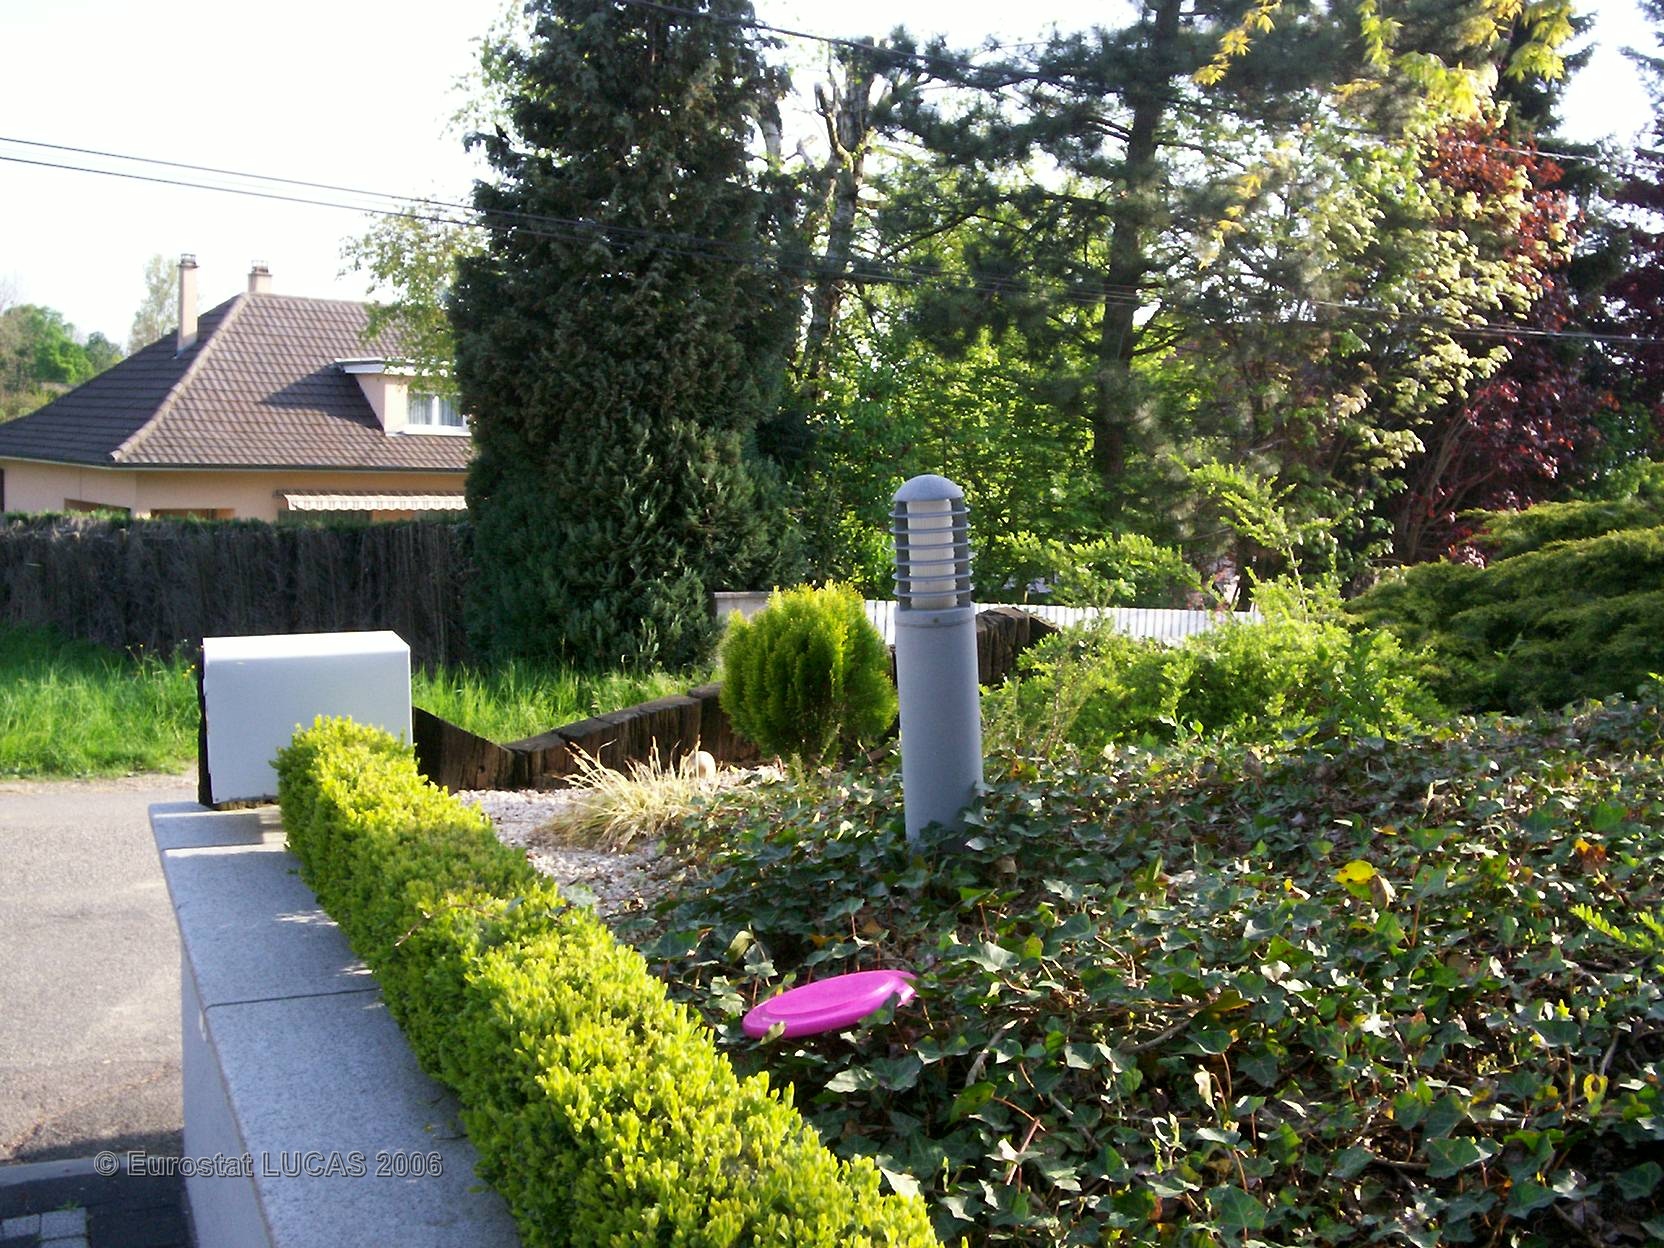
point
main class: Cropland
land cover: Floriculture and ornamental plants
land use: Residential
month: May
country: FR
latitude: 47.6175
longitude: 7.4337
